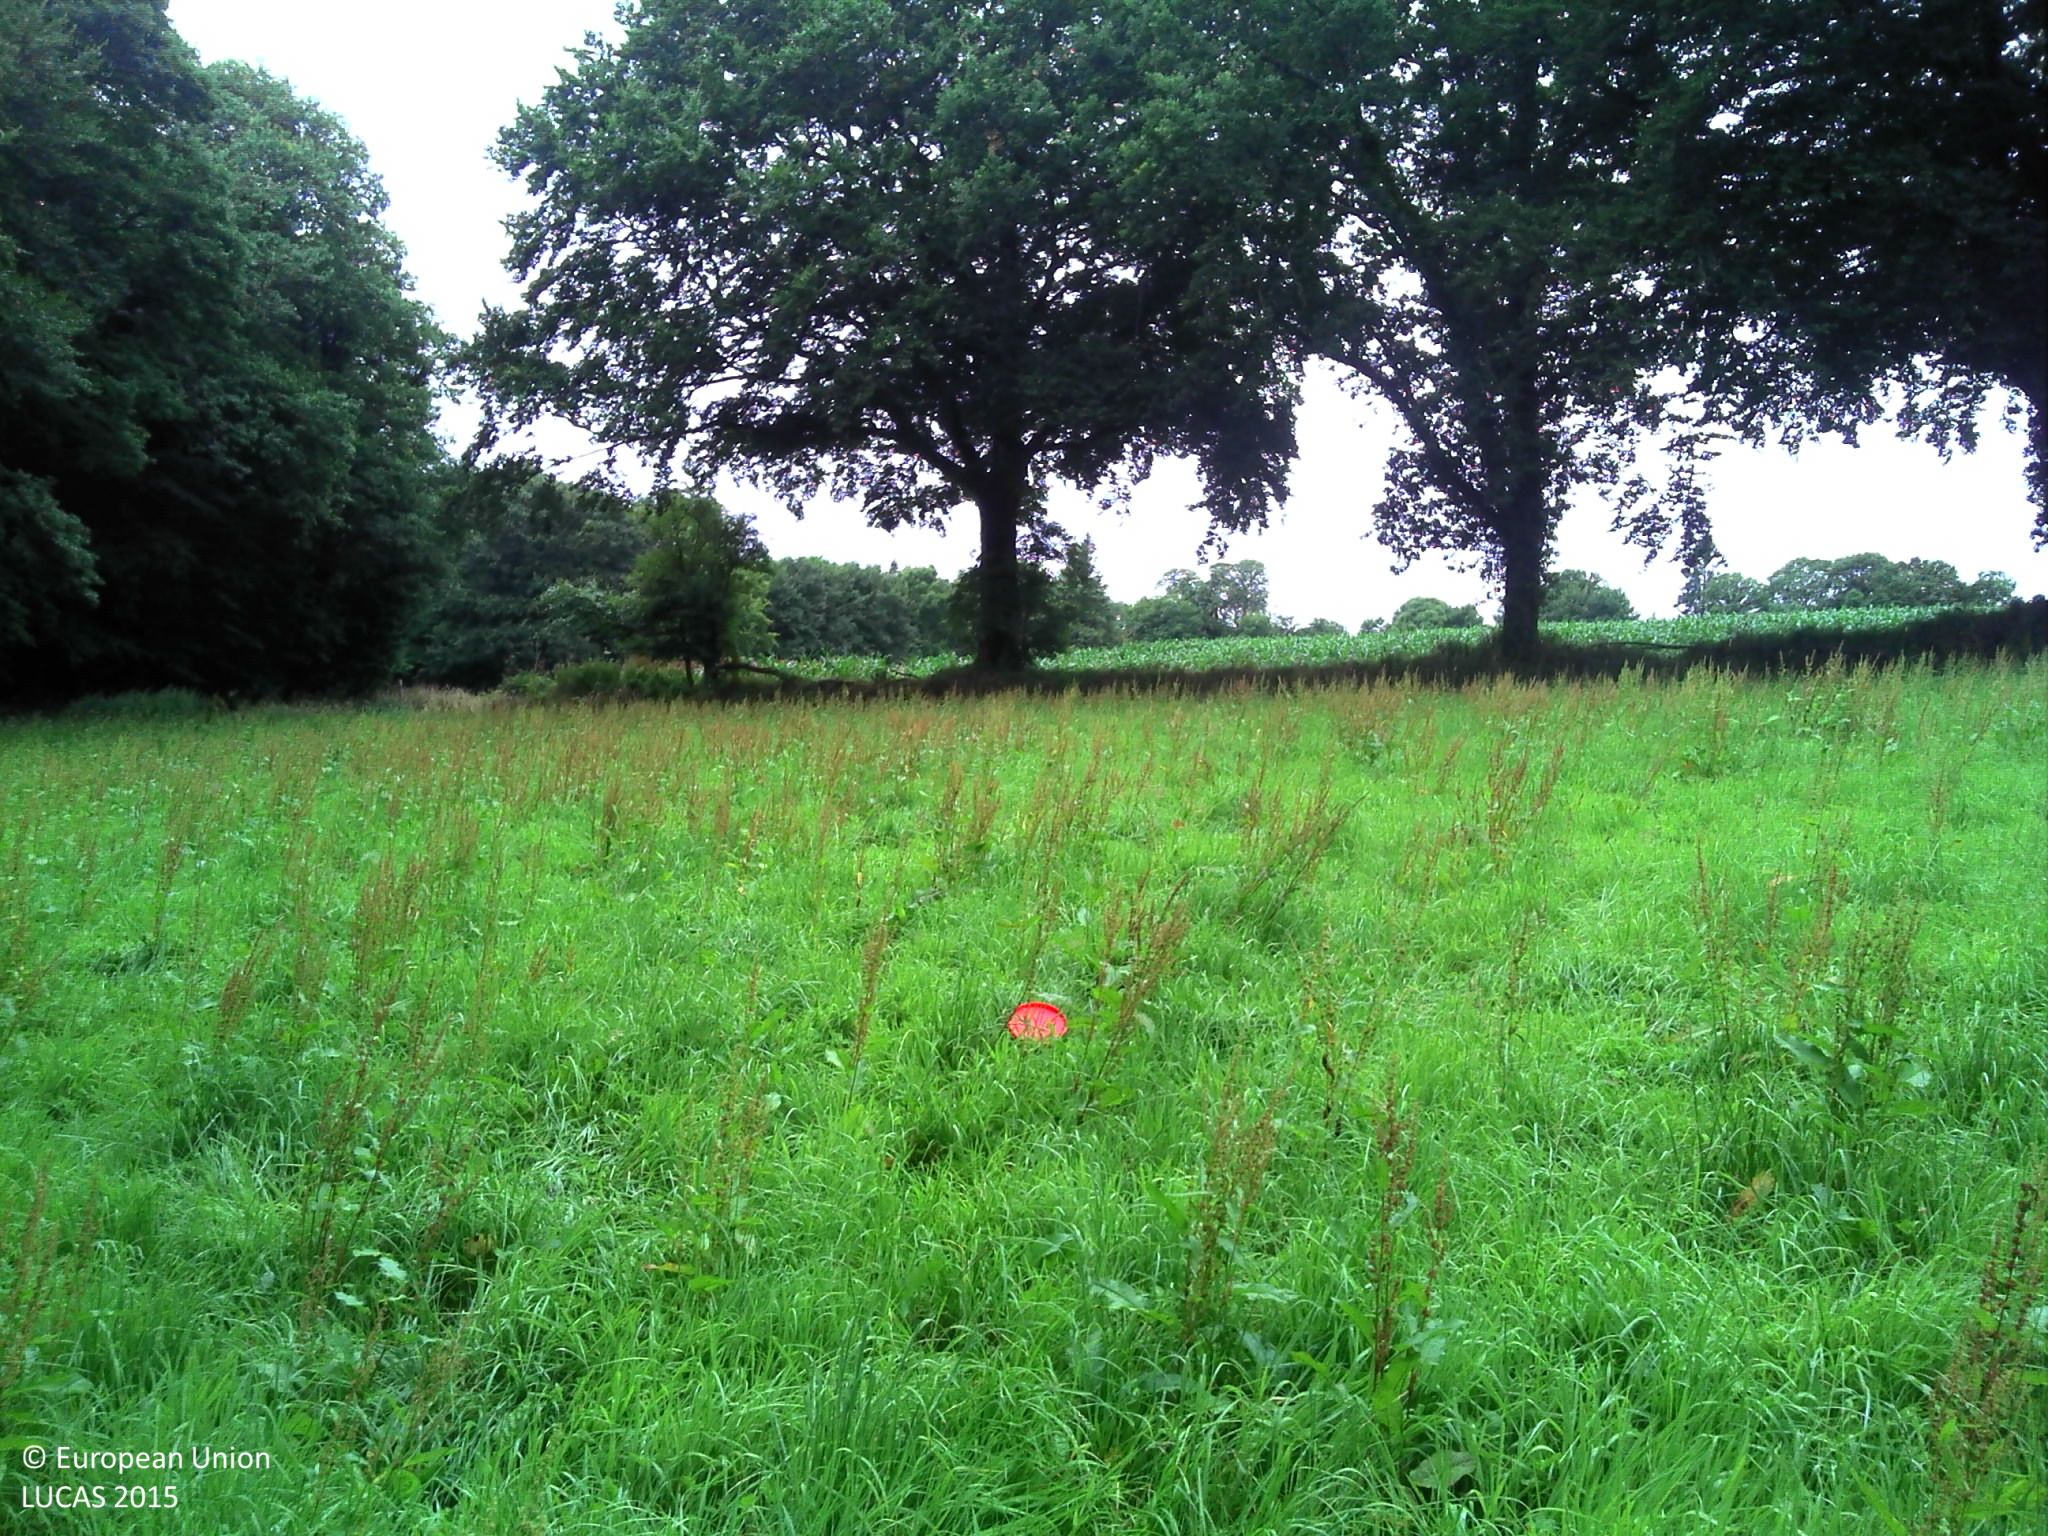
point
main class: Grassland
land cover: Grassland without tree/shrub cover
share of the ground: > 75 %
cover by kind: herbaceous plants 100 %
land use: Agriculture (excluding fallow land and kitchen gardens)
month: July
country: FR
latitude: 48.8914
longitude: -1.3254
